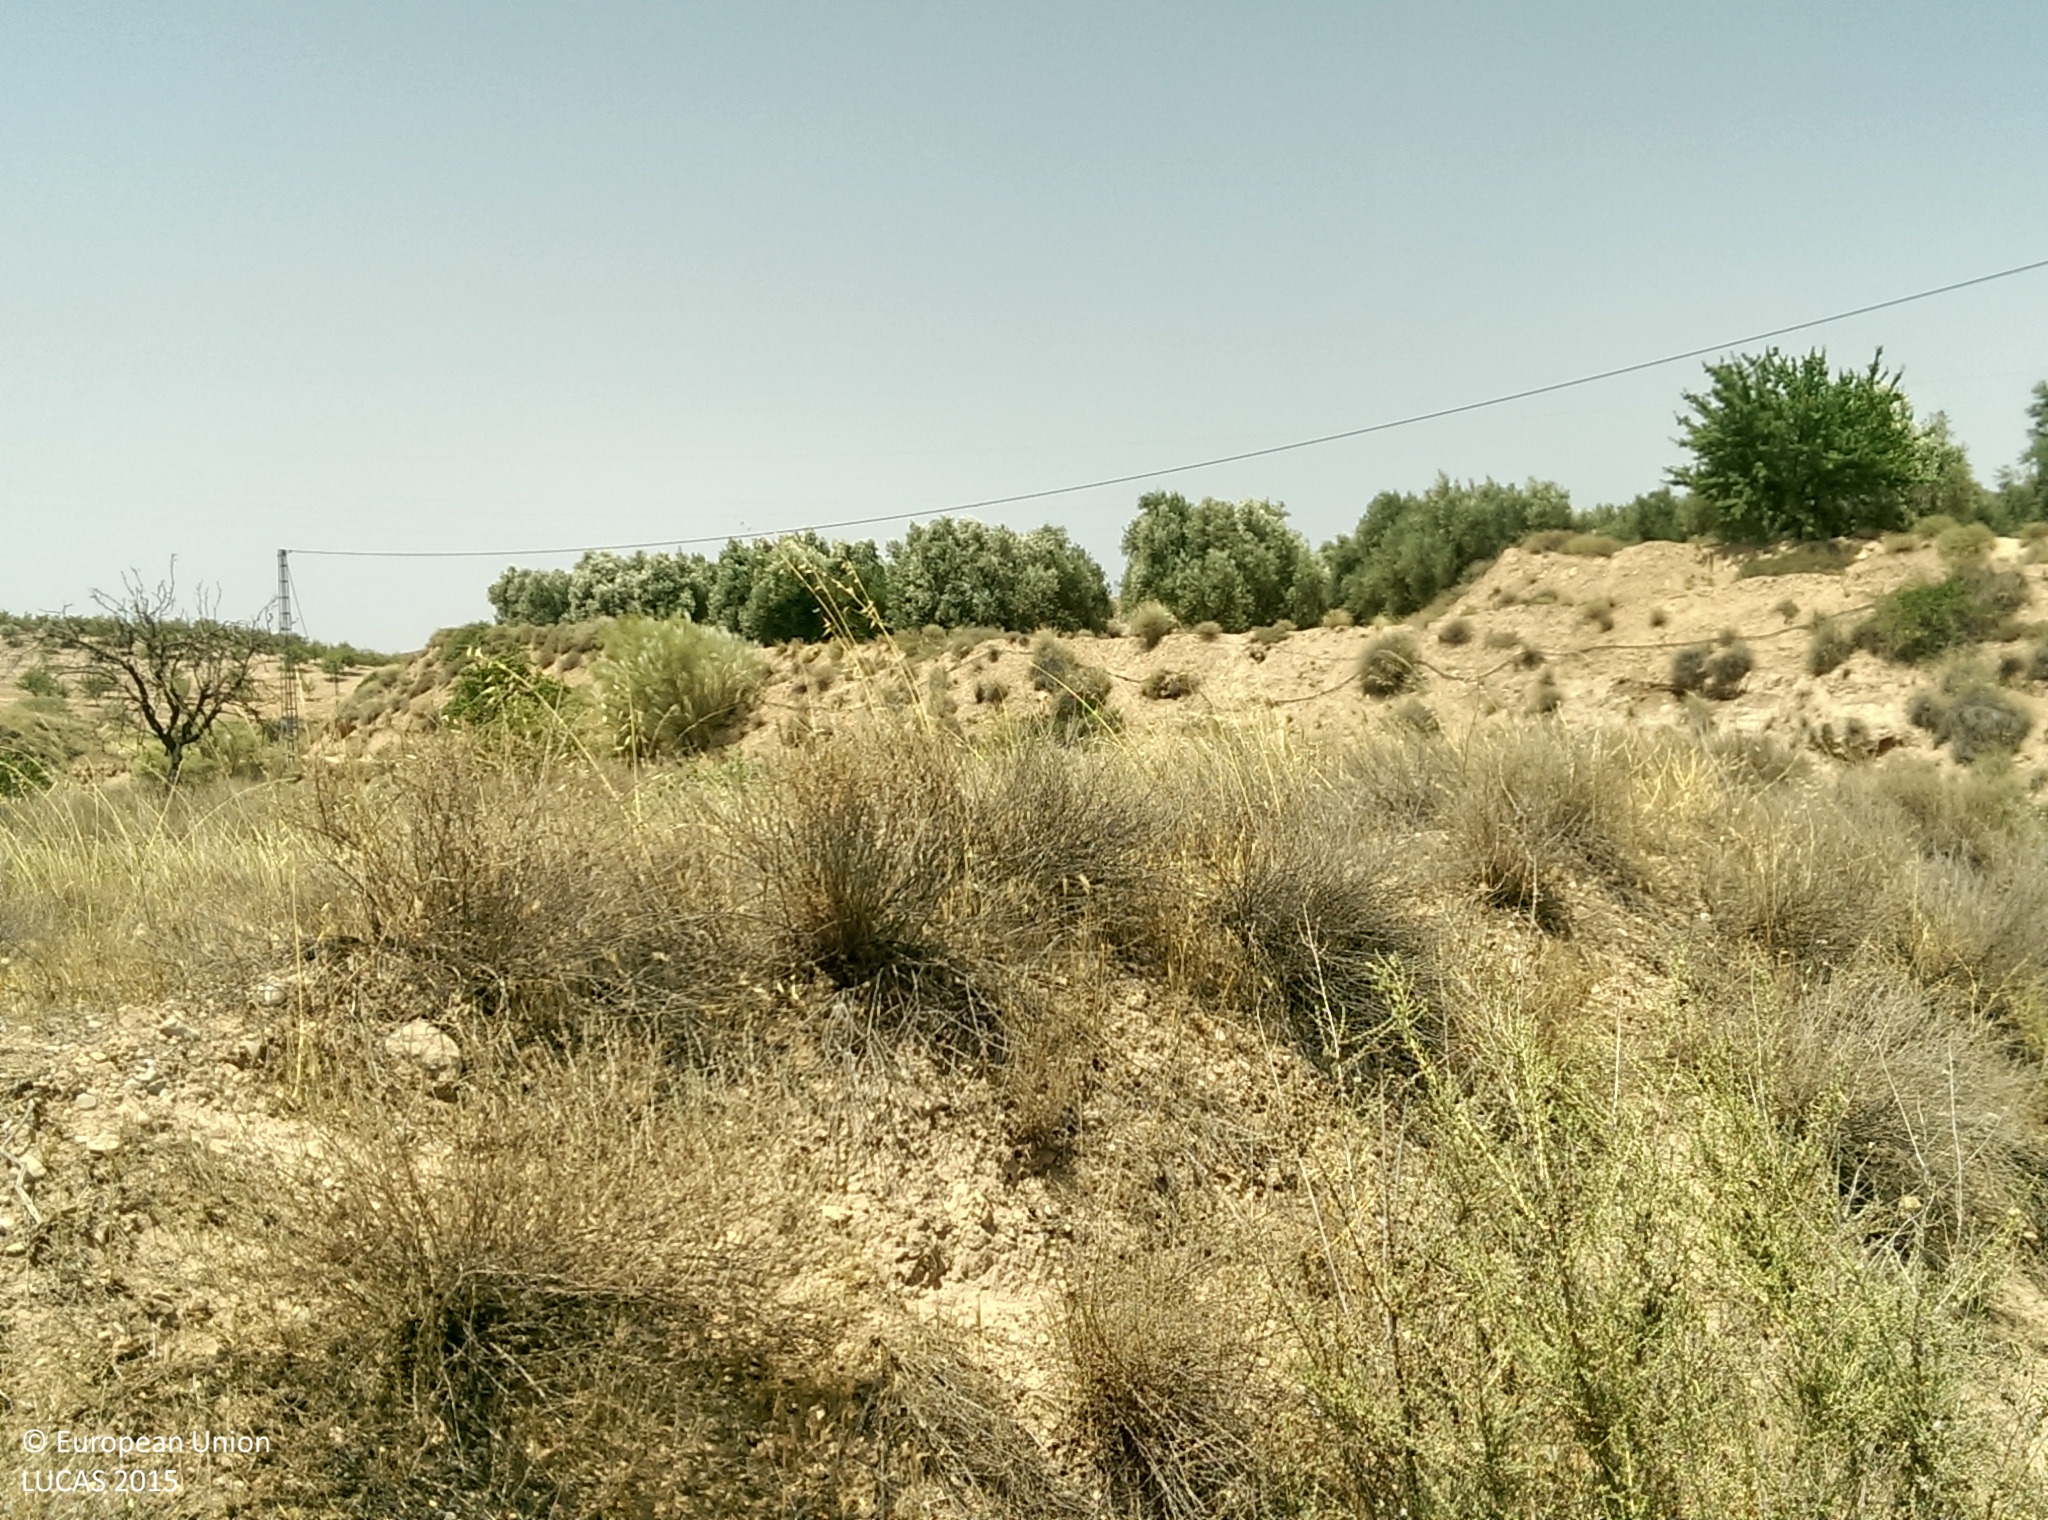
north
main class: Shrubland
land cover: Shrubland with sparse tree cover
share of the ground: 50 - 75 %
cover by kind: shrubs 55 %, herbaceous plants 30 %, unconsolidated bare surface 10 %, coniferous forest trees 5 %
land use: Abandoned areas
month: July
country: ES
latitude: 37.5283
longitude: -2.8771
